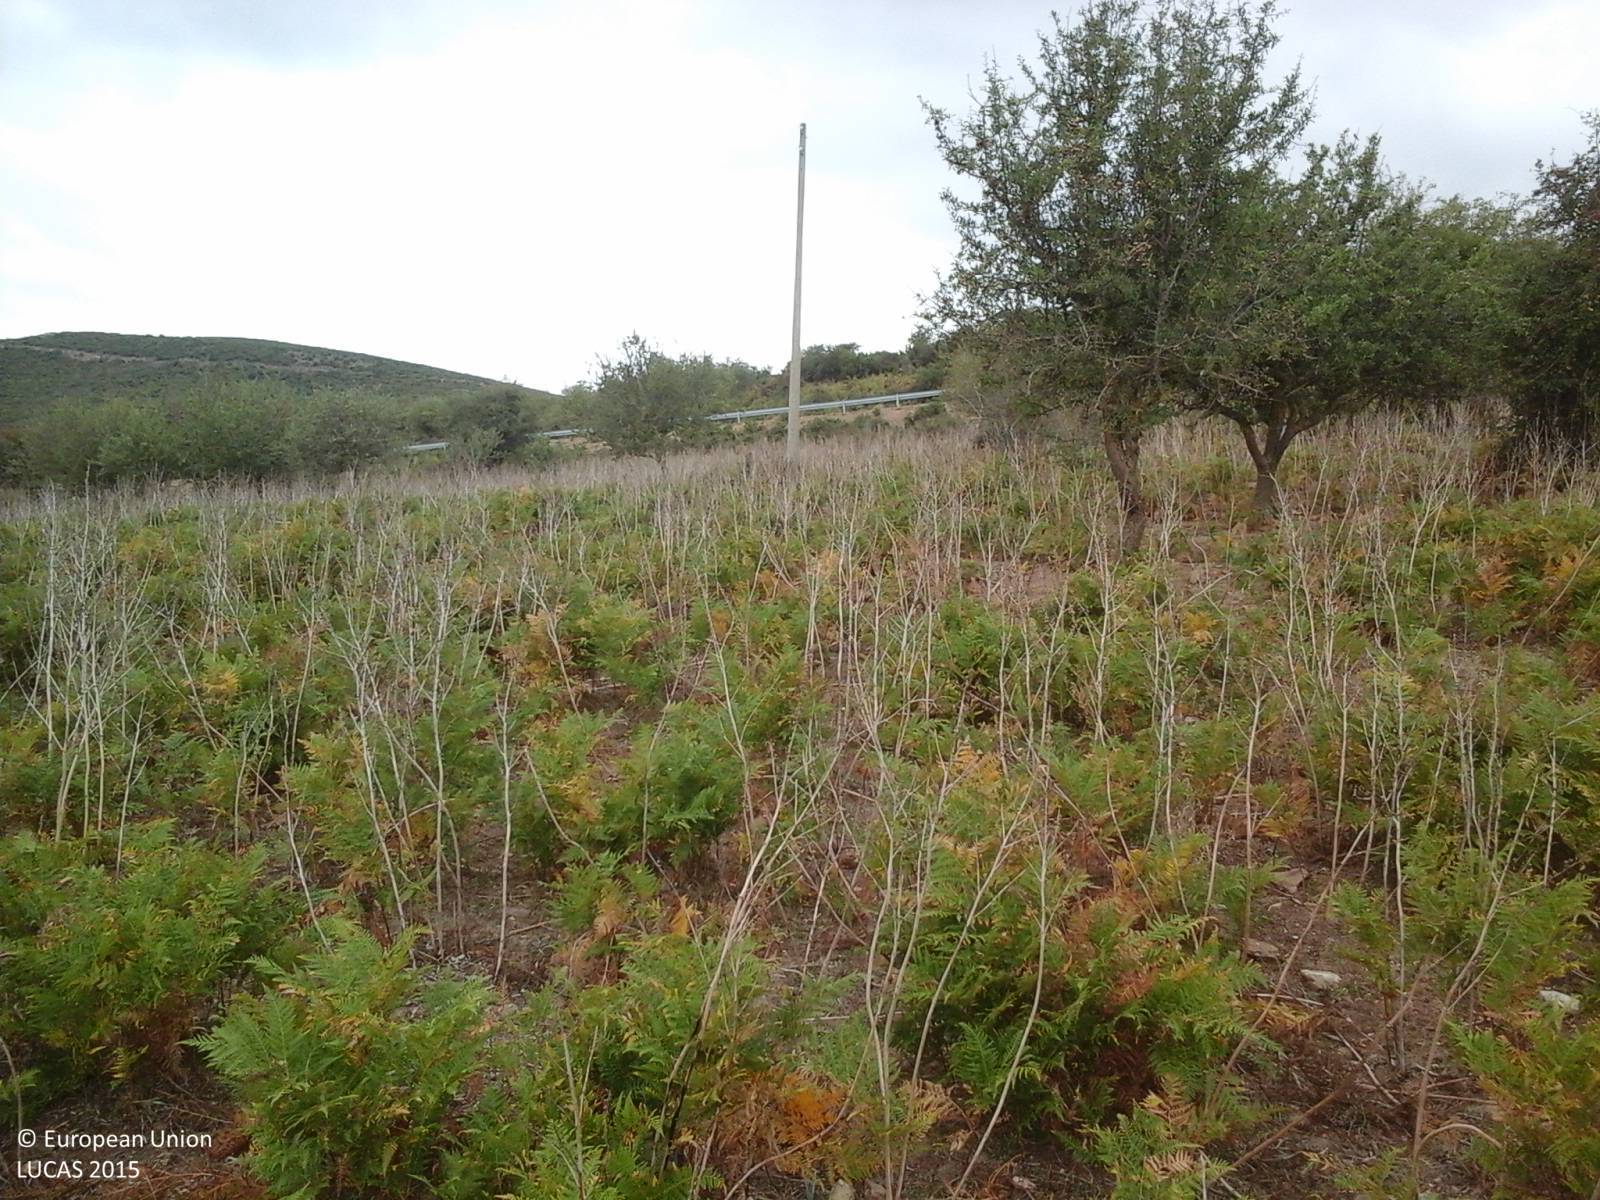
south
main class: Grassland
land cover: Grassland with sparse tree/shrub cover
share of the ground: > 75 %
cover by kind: herbaceous plants 90 %, broadleaved forest trees 5 %, shrubs 5 %
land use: Agriculture (excluding fallow land and kitchen gardens)
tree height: < 5 m
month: September
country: IT
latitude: 40.1385
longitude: 9.3579
